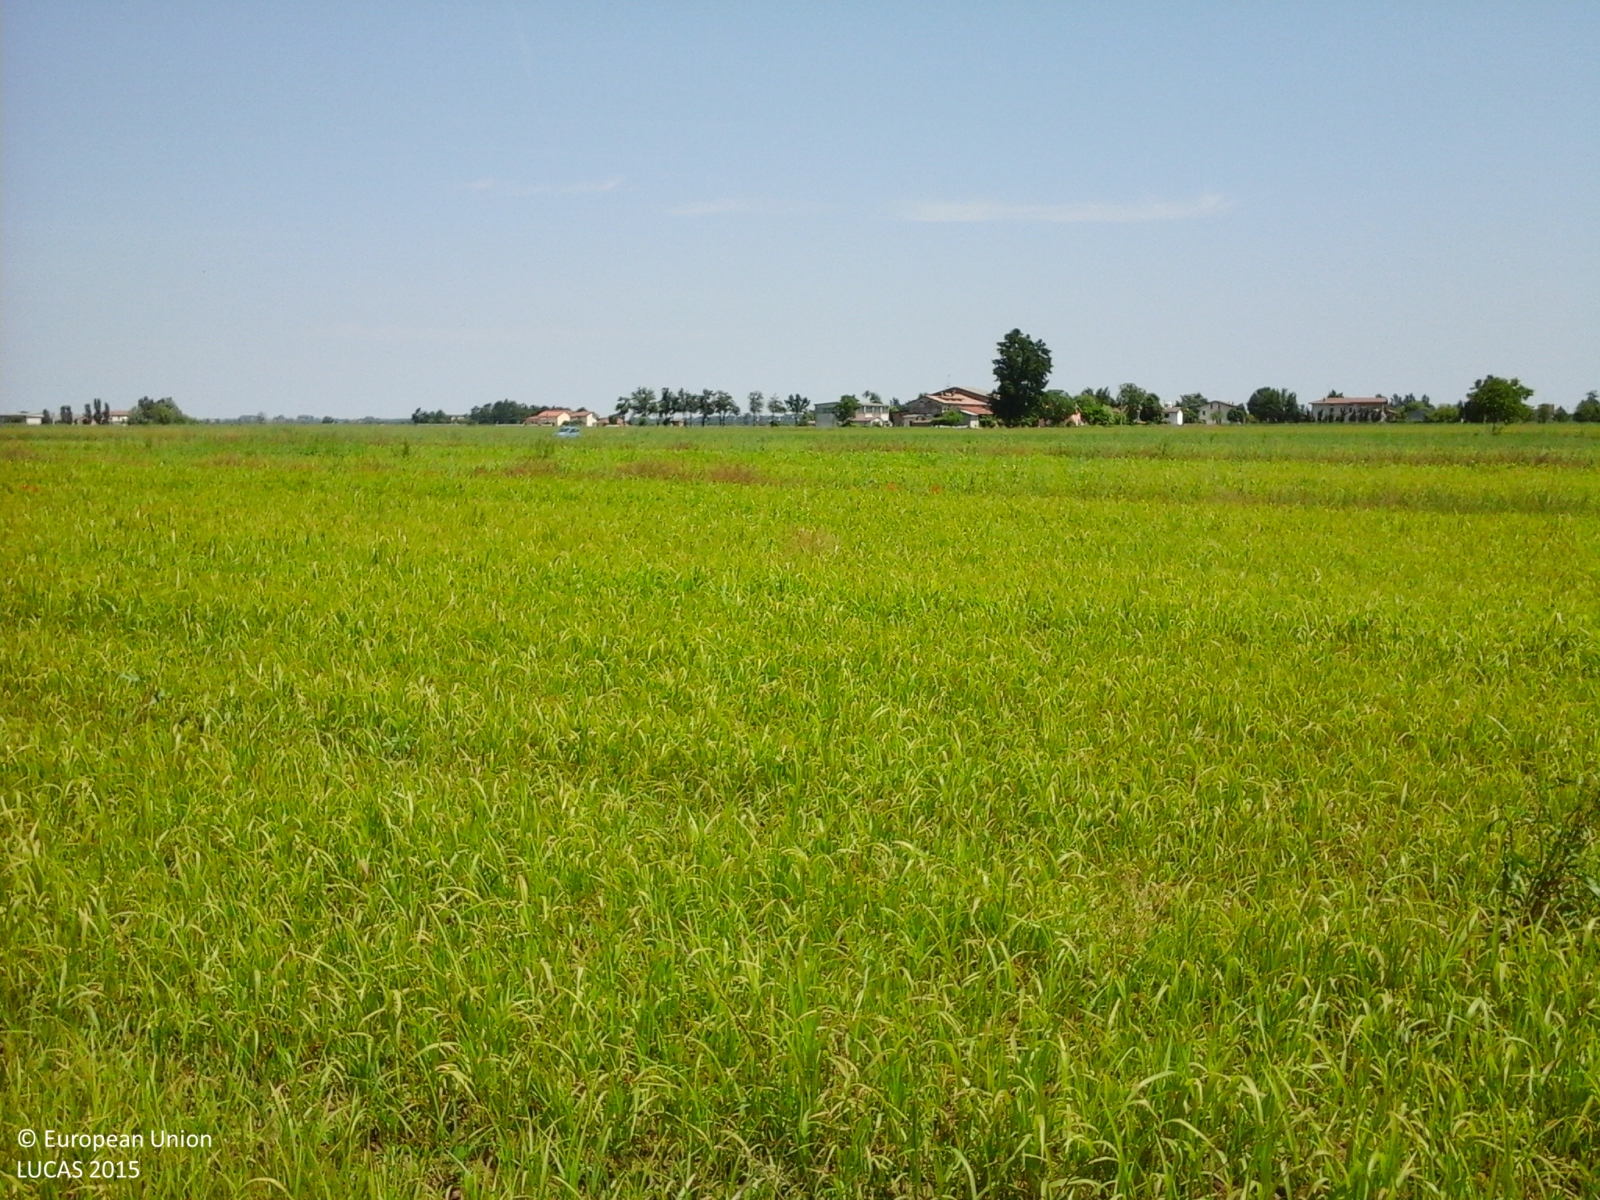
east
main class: Cropland
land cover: Temporary grasslands
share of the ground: > 75 %
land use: Agriculture (excluding fallow land and kitchen gardens)
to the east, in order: Temporary grasslands; Ditches and canals; Temporary grasslands; Ditches and canals; Temporary grasslands; Ditches and canals; Temporary grasslands; Ditches and canals; Temporary grasslands; Ditches and canals; Grass margins; Paved roads, cycling and walking lanes; Grass margins; Common wheat; Paved roads, cycling and walking lanes; Grass margins; Ditches and canals
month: May
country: IT
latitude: 44.8359
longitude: 10.5681
